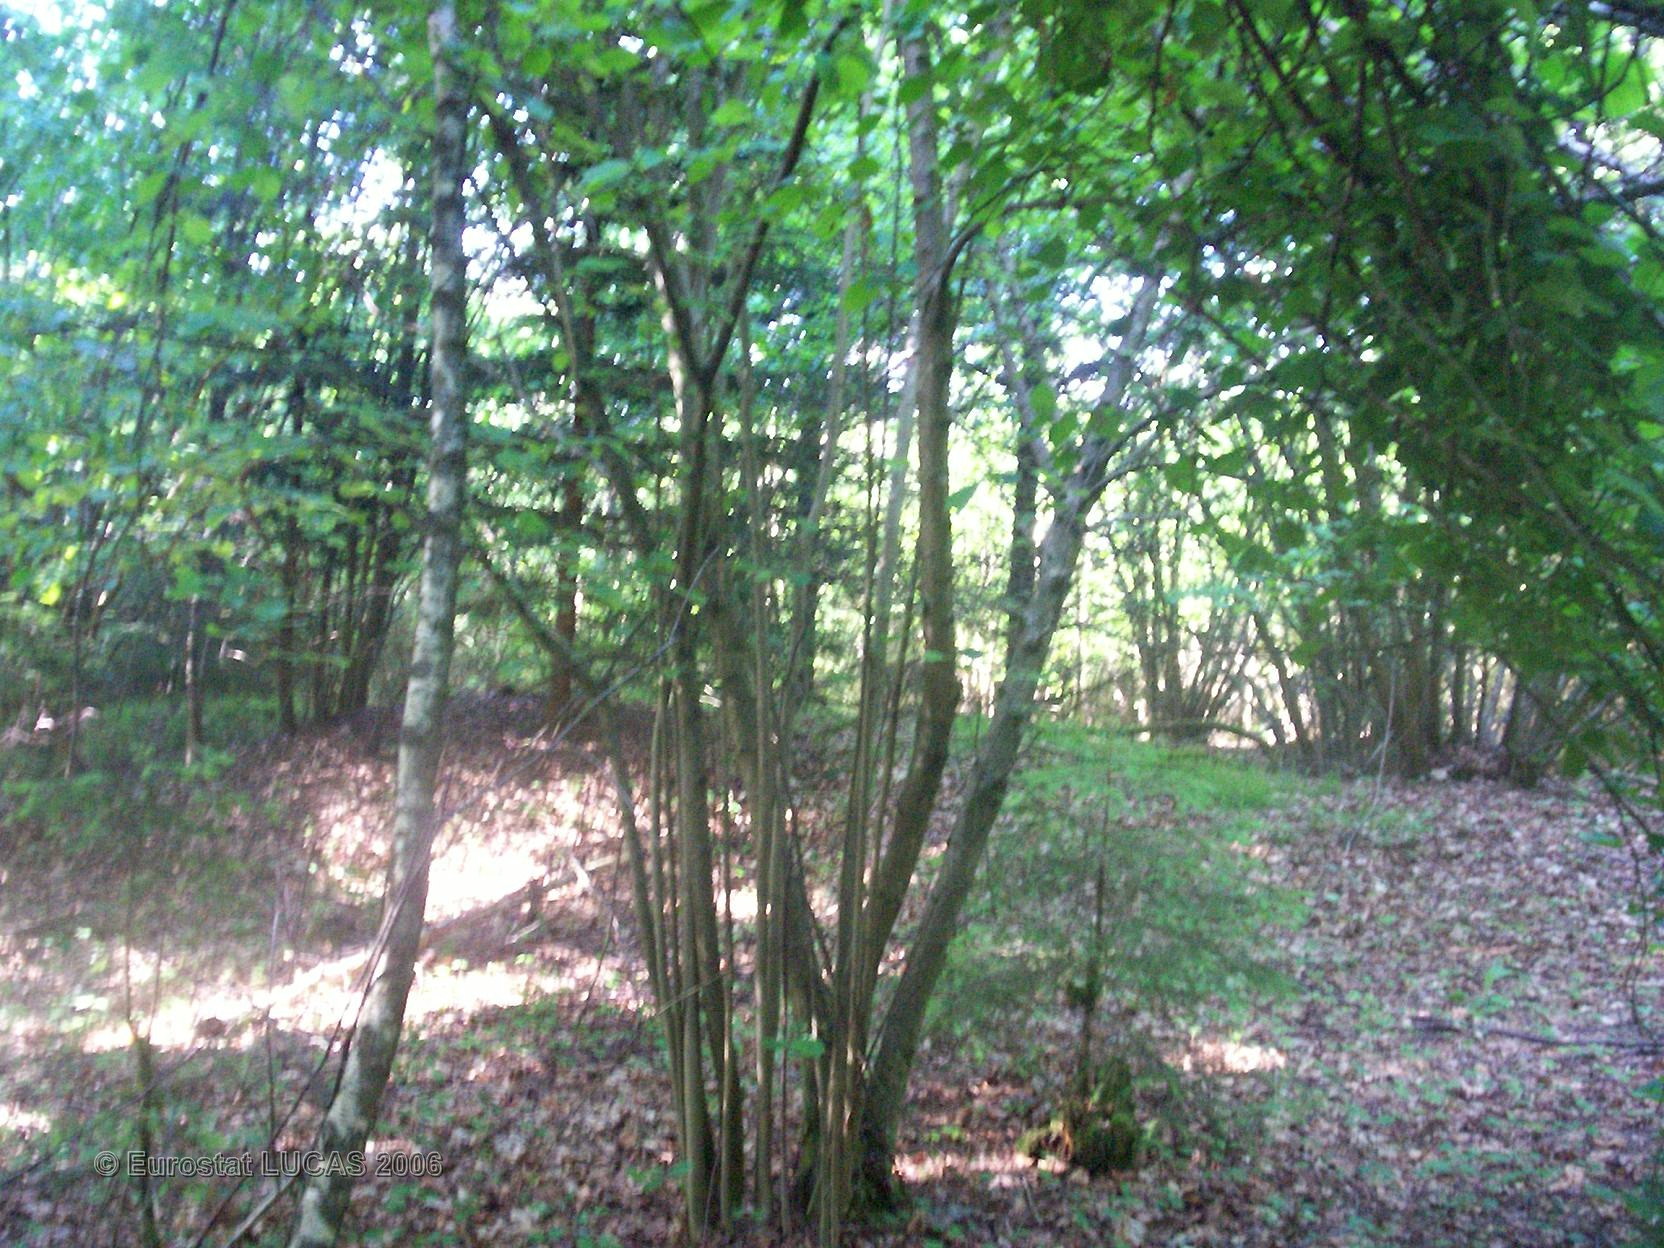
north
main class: Woodland
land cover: Coniferous forest
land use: Forestry
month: June
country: FR
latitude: 48.3274
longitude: 7.0200
